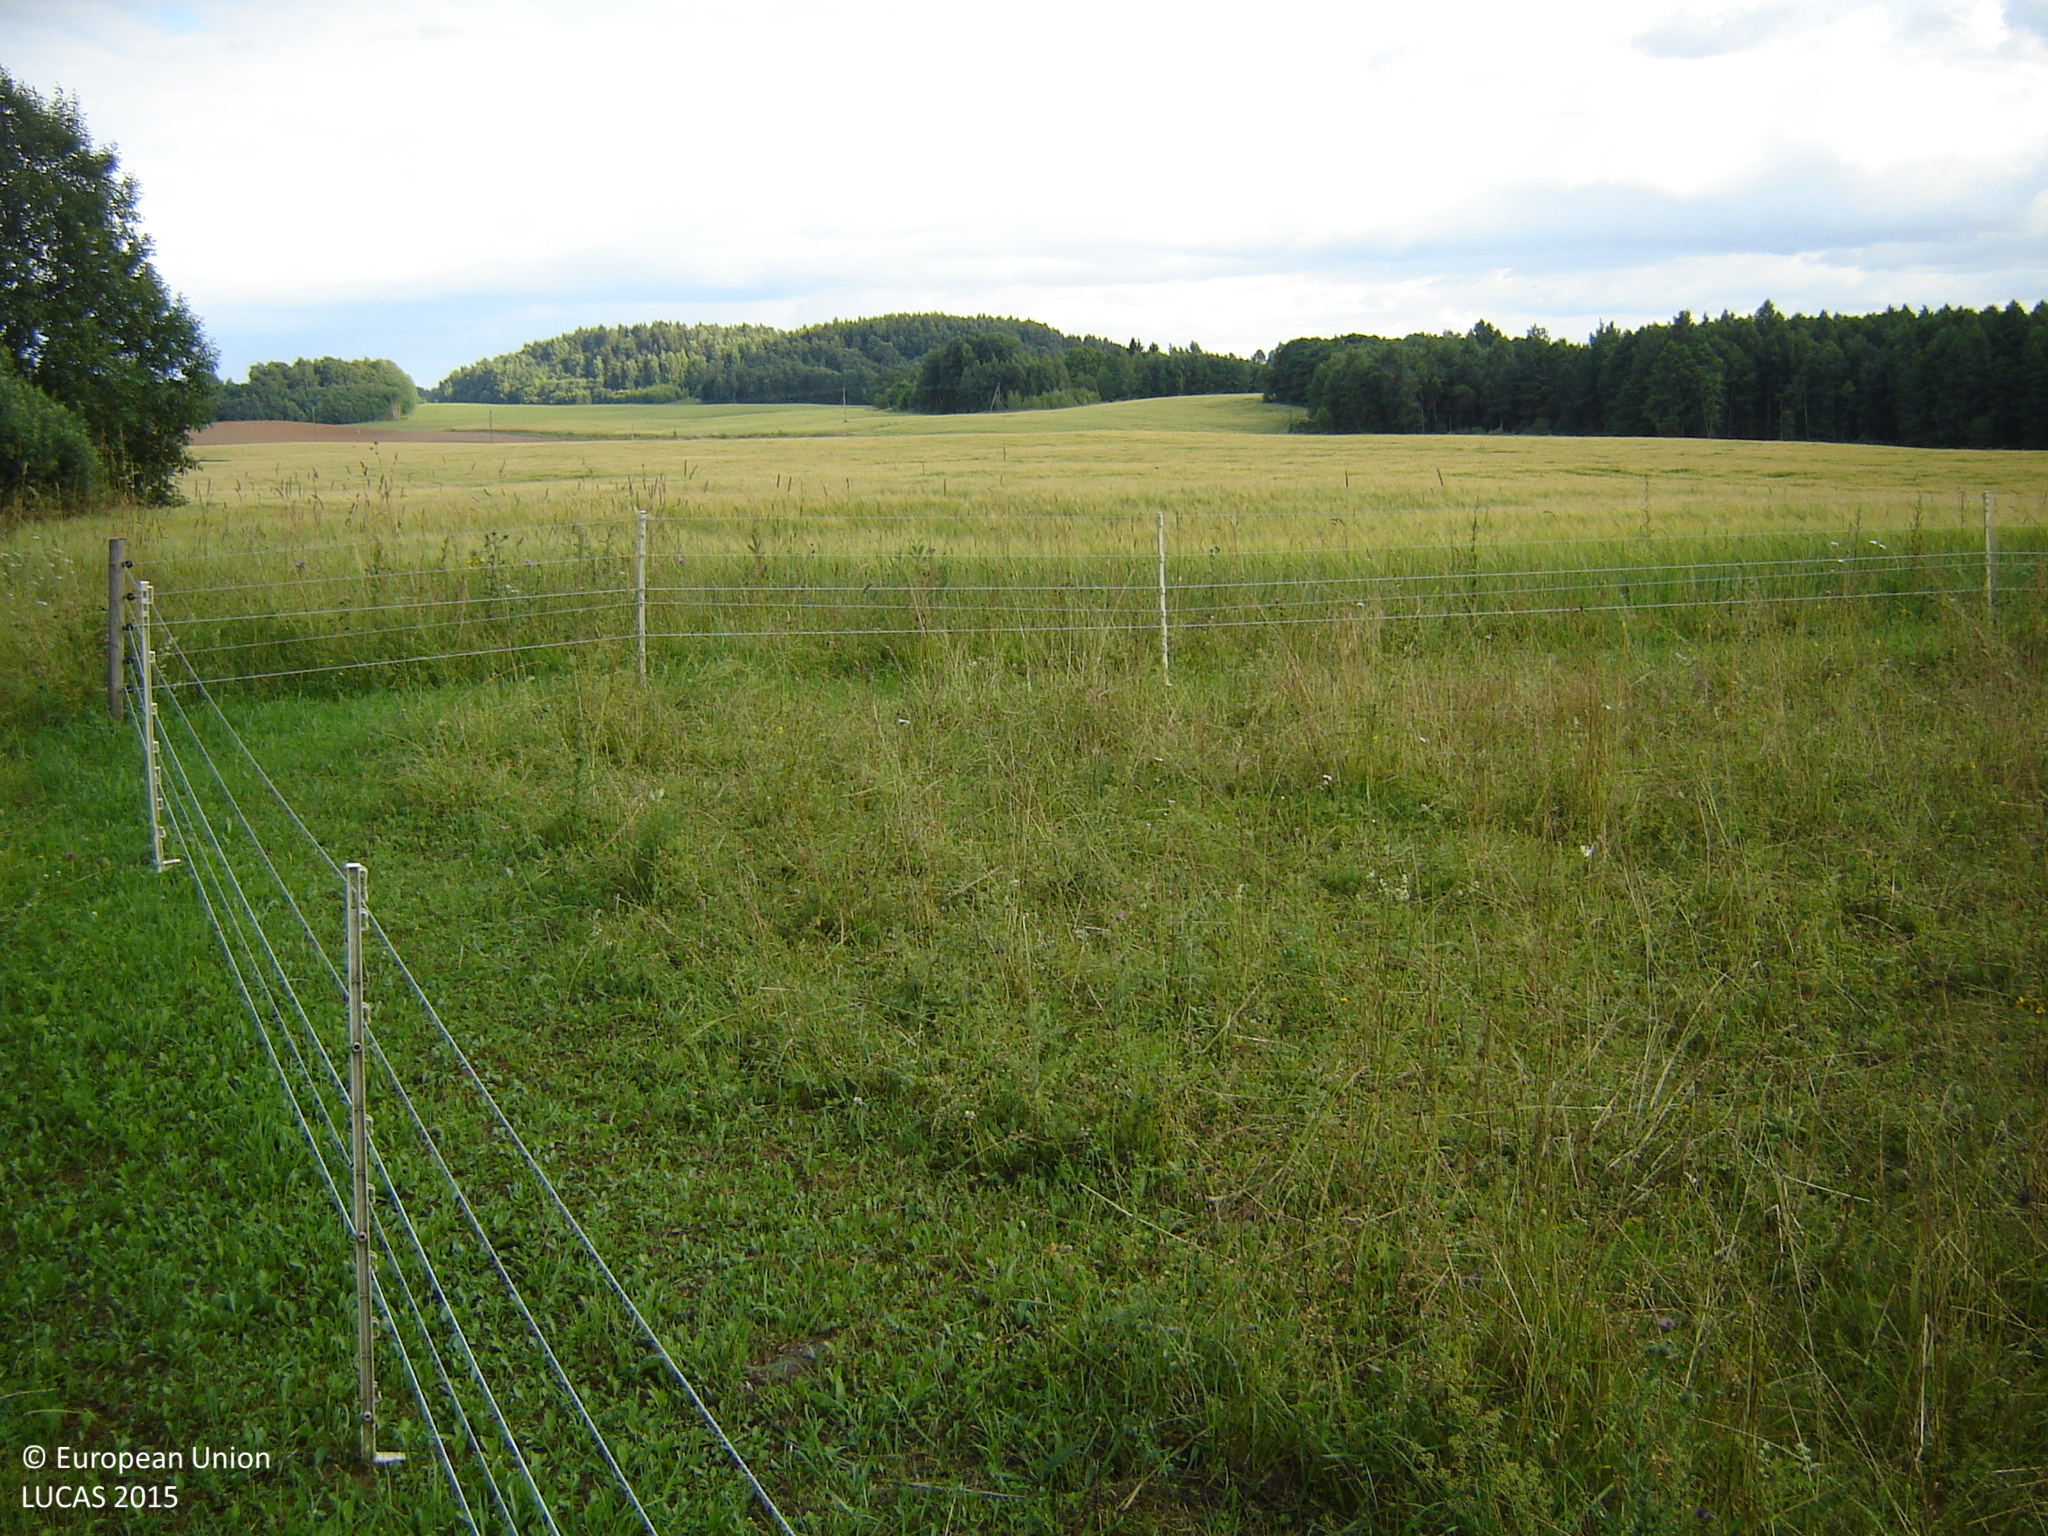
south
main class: Grassland
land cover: Grassland without tree/shrub cover
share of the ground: > 75 %
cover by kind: herbaceous plants 100 %
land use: Agriculture (excluding fallow land and kitchen gardens)
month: July
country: LT
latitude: 55.5018
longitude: 25.1393
